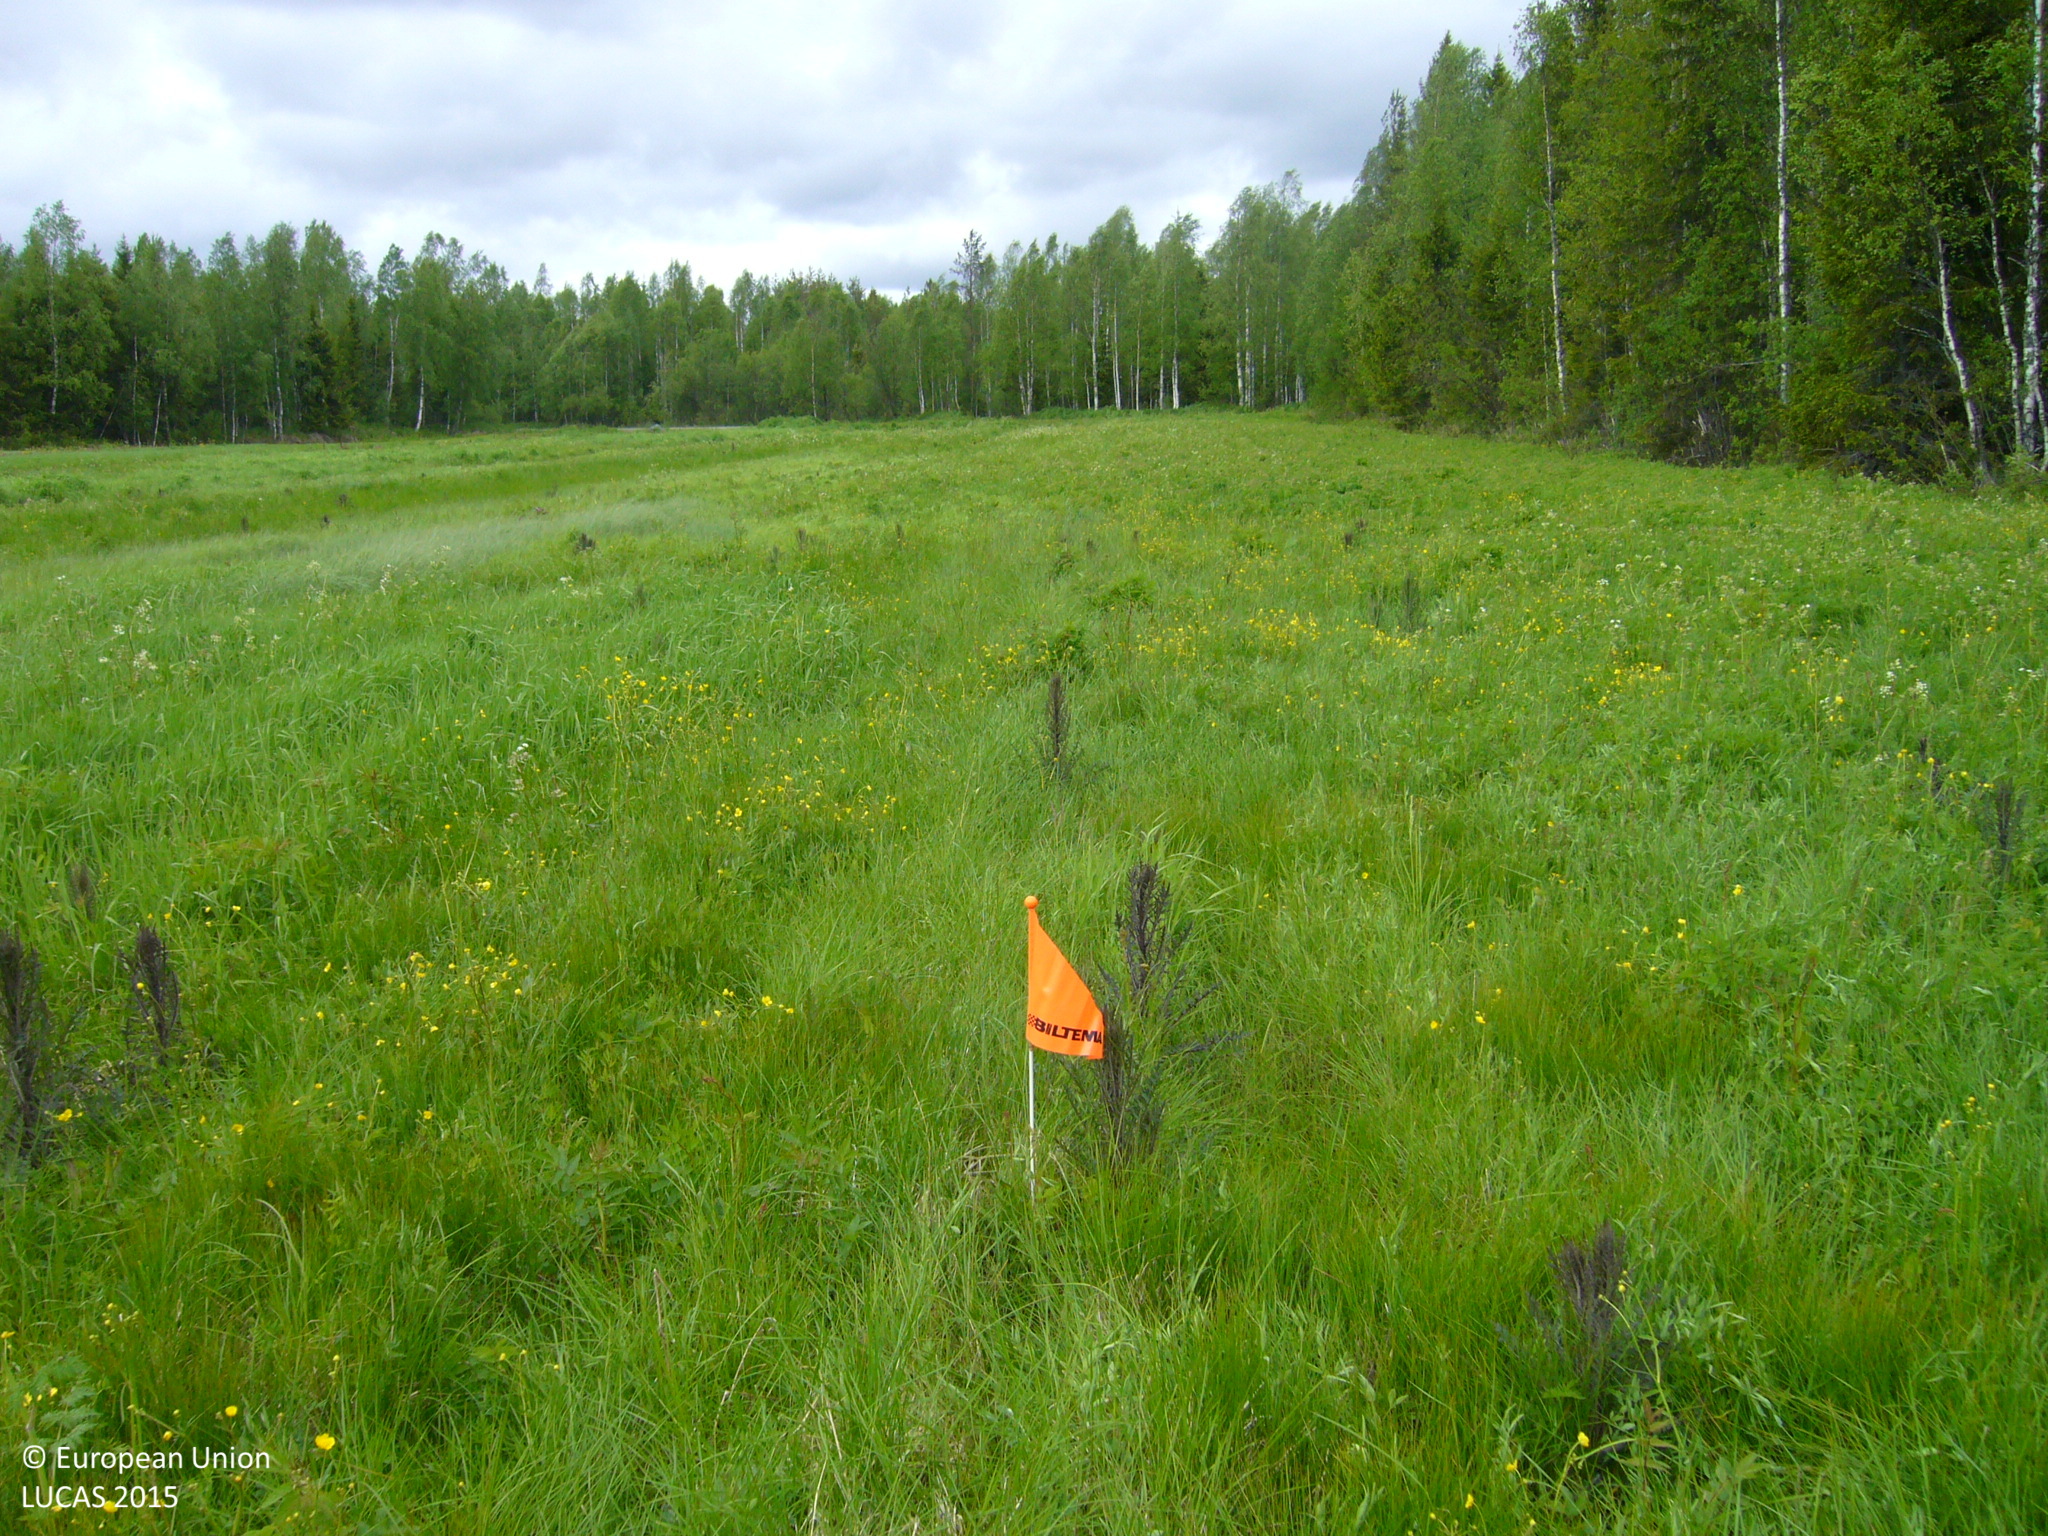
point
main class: Grassland
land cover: Spontaneously vegetated surfaces
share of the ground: > 75 %
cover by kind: herbaceous plants 100 %
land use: Fallow land
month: June
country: FI
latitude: 63.8903
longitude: 27.0621
